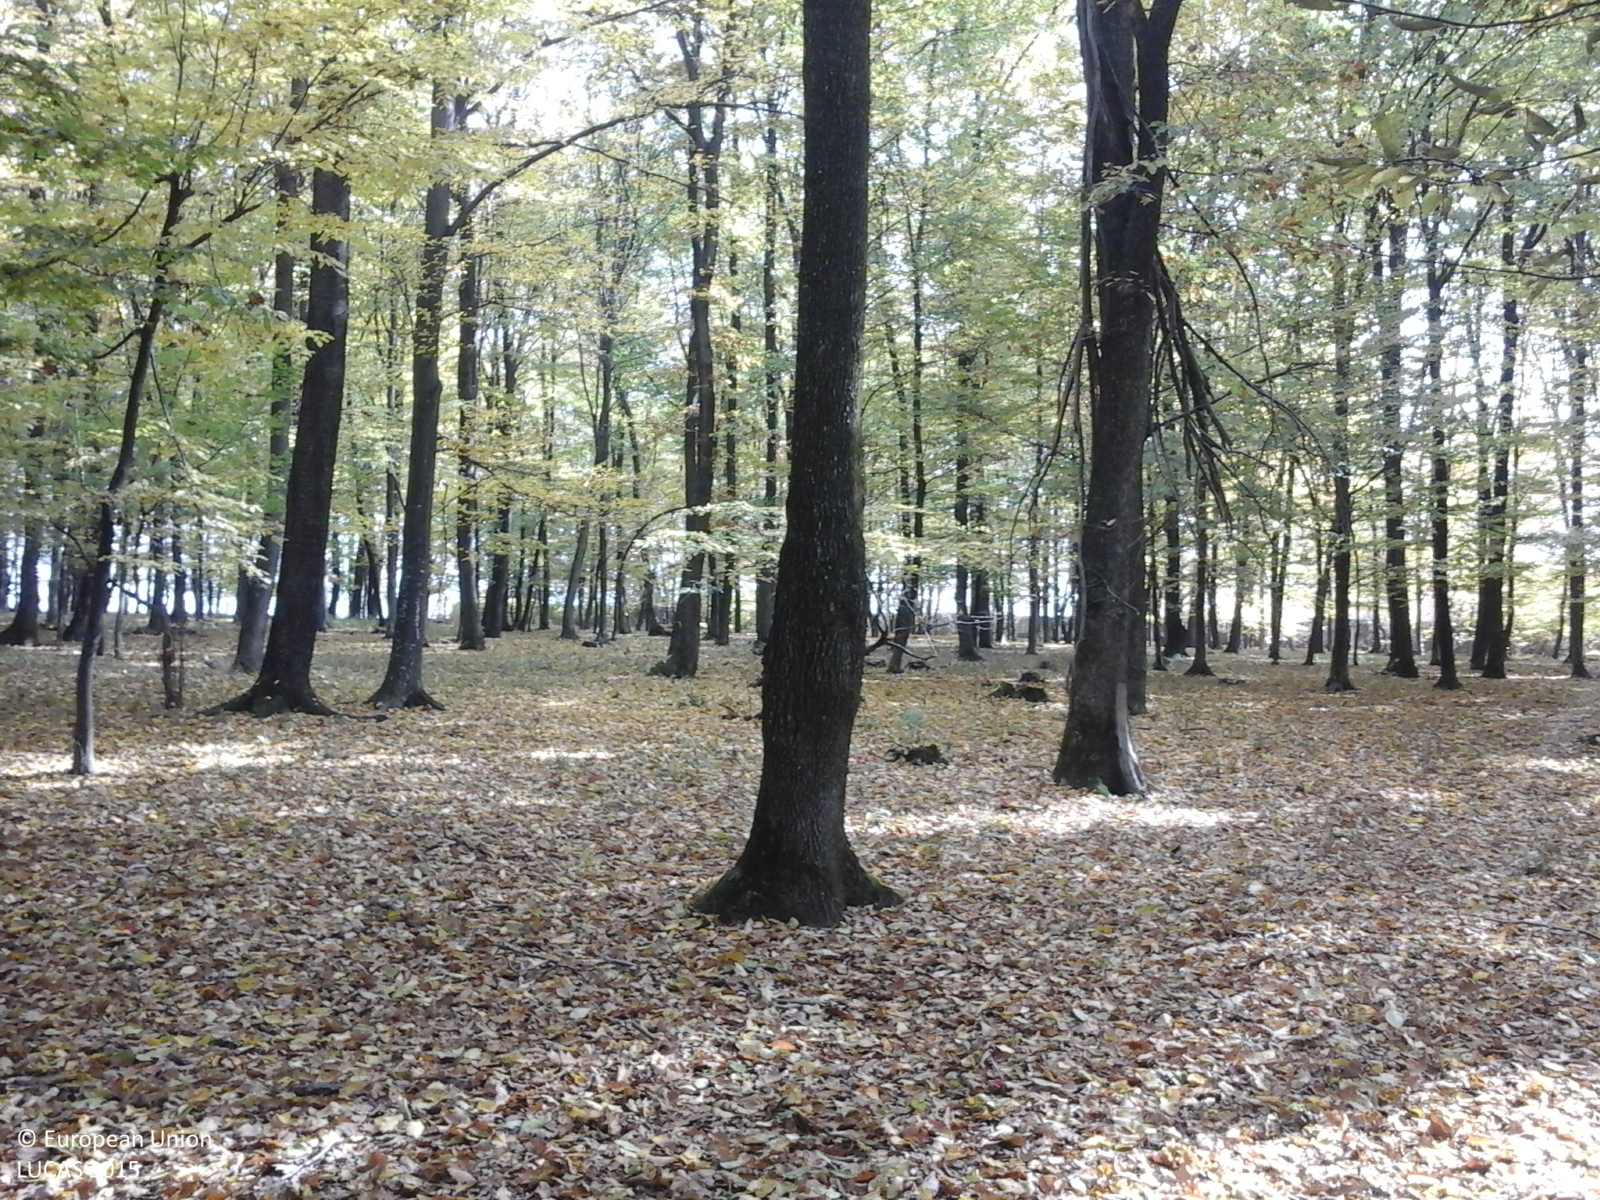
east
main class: Woodland
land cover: Broadleaved woodland
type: beech forest
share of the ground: > 75 %
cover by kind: broadleaved forest trees 100 %
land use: Forestry
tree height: > 5 m
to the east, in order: Broadleaved woodland; Artificial constructions in urban areas; Other bare soil; Electric lines; Other bare soil
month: October
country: RO
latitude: 46.0090
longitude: 27.1035
